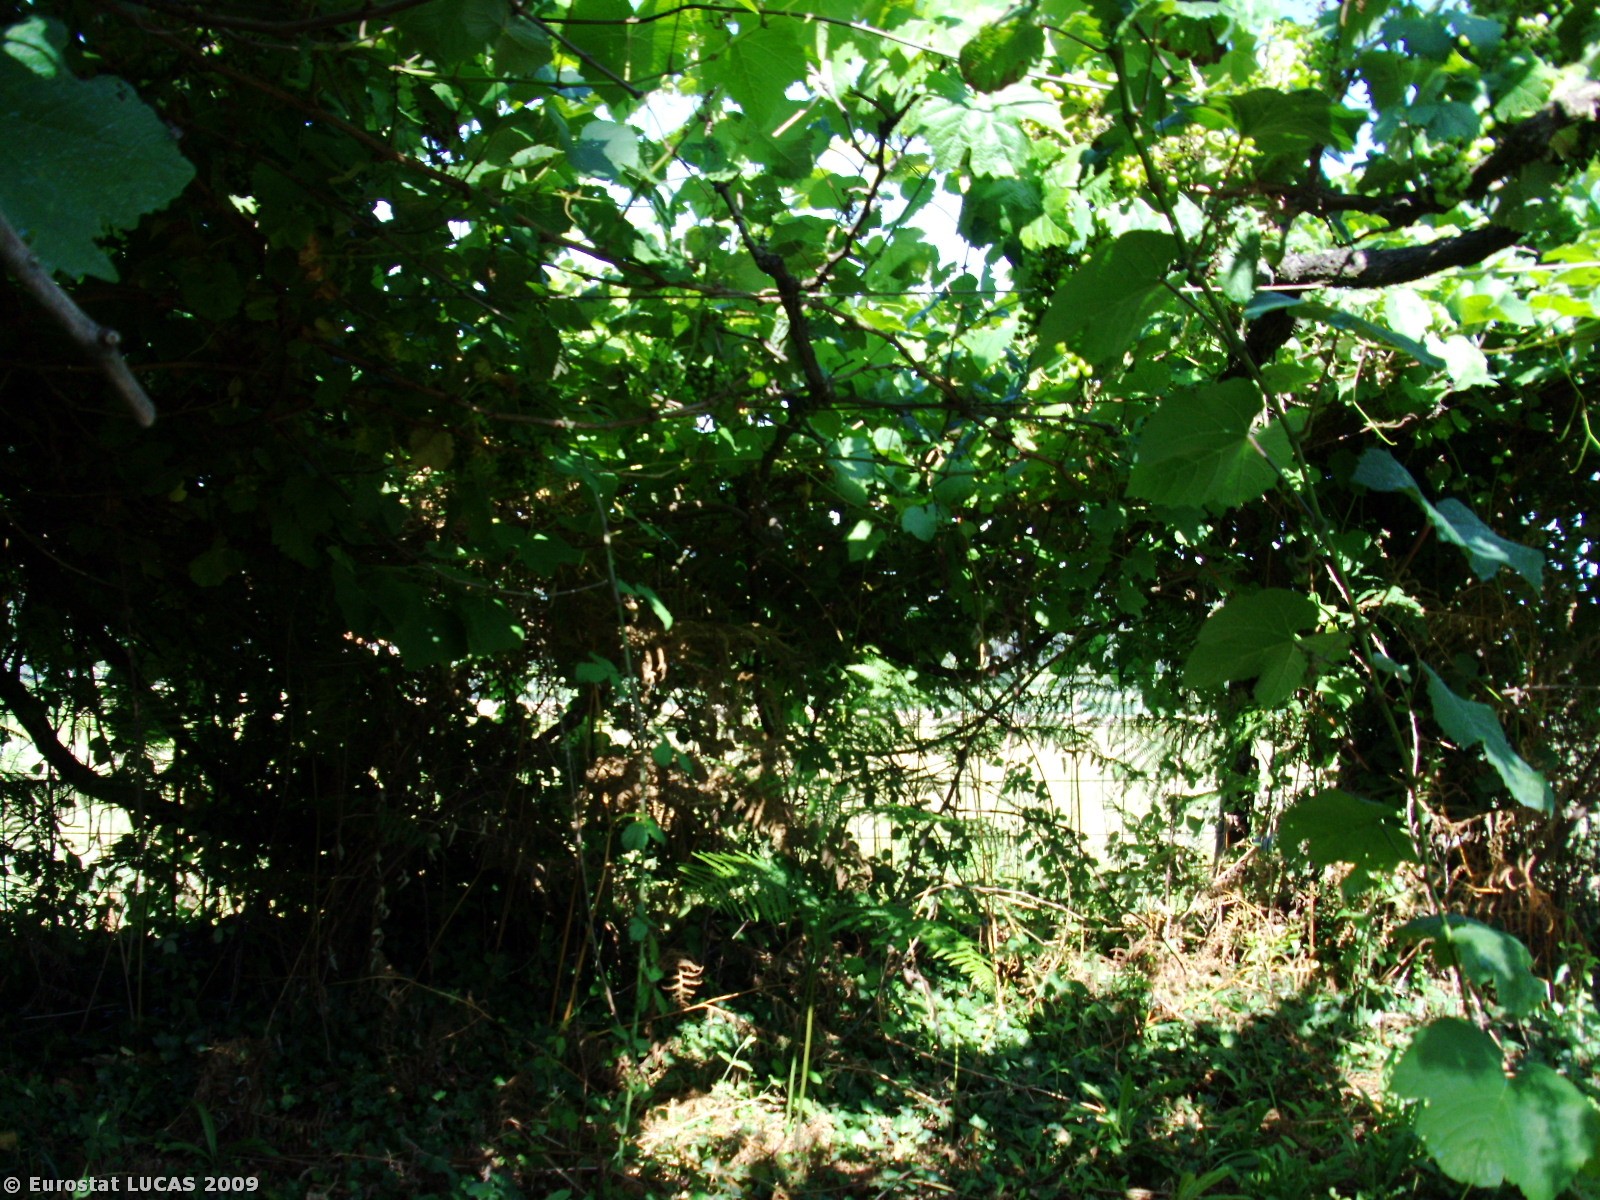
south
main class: Woodland
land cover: Broadleaved woodland
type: acidophilous oak and oak-birch forest
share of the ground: 50 - 75 %
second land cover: Spontaneously vegetated surfaces
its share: 25 - 50 %
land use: Agriculture (excluding fallow land and kitchen gardens)
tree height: > 5 m
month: July
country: PT
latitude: 41.5530
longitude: -8.7346
